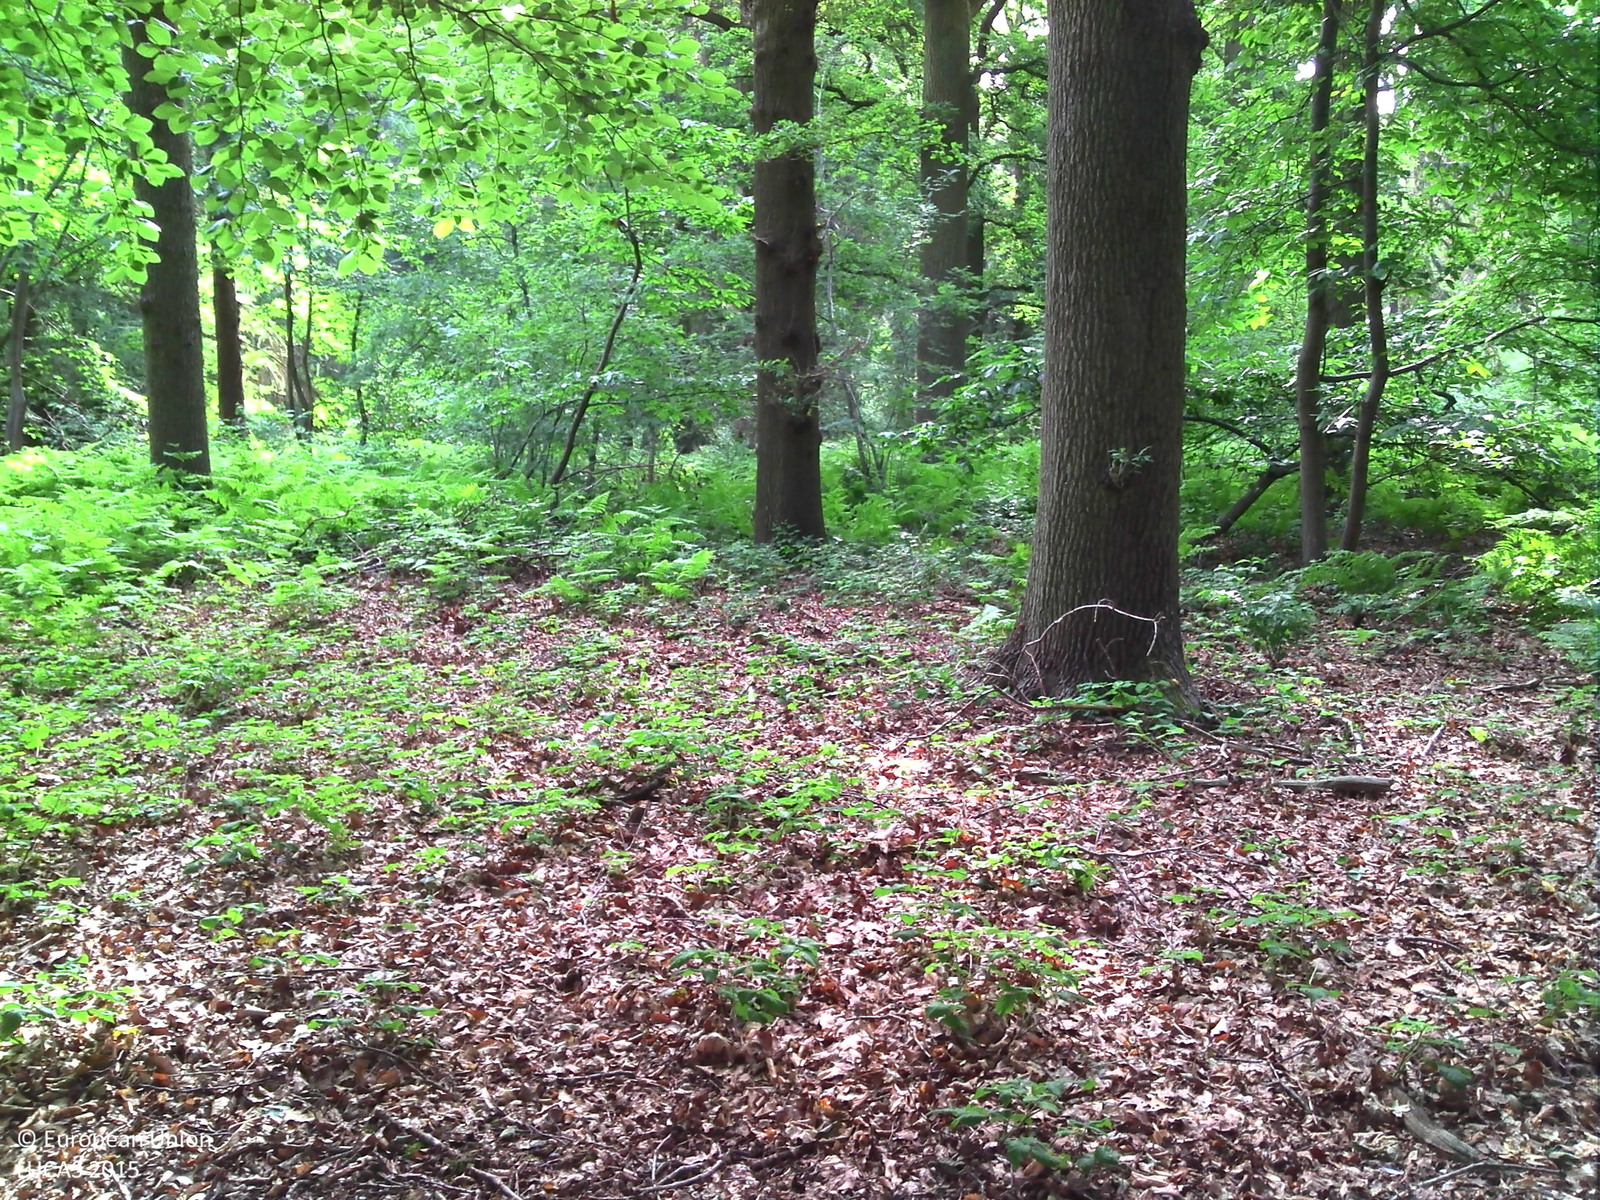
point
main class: Woodland
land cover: Broadleaved woodland
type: acidophilous oak and oak-birch forest
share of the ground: > 75 %
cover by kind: broadleaved forest trees 95 %, herbaceous plants 5 %
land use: Forestry
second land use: Amenities, museums, leisure
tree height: > 5 m
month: June
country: BE
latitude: 50.8897
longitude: 5.5486
